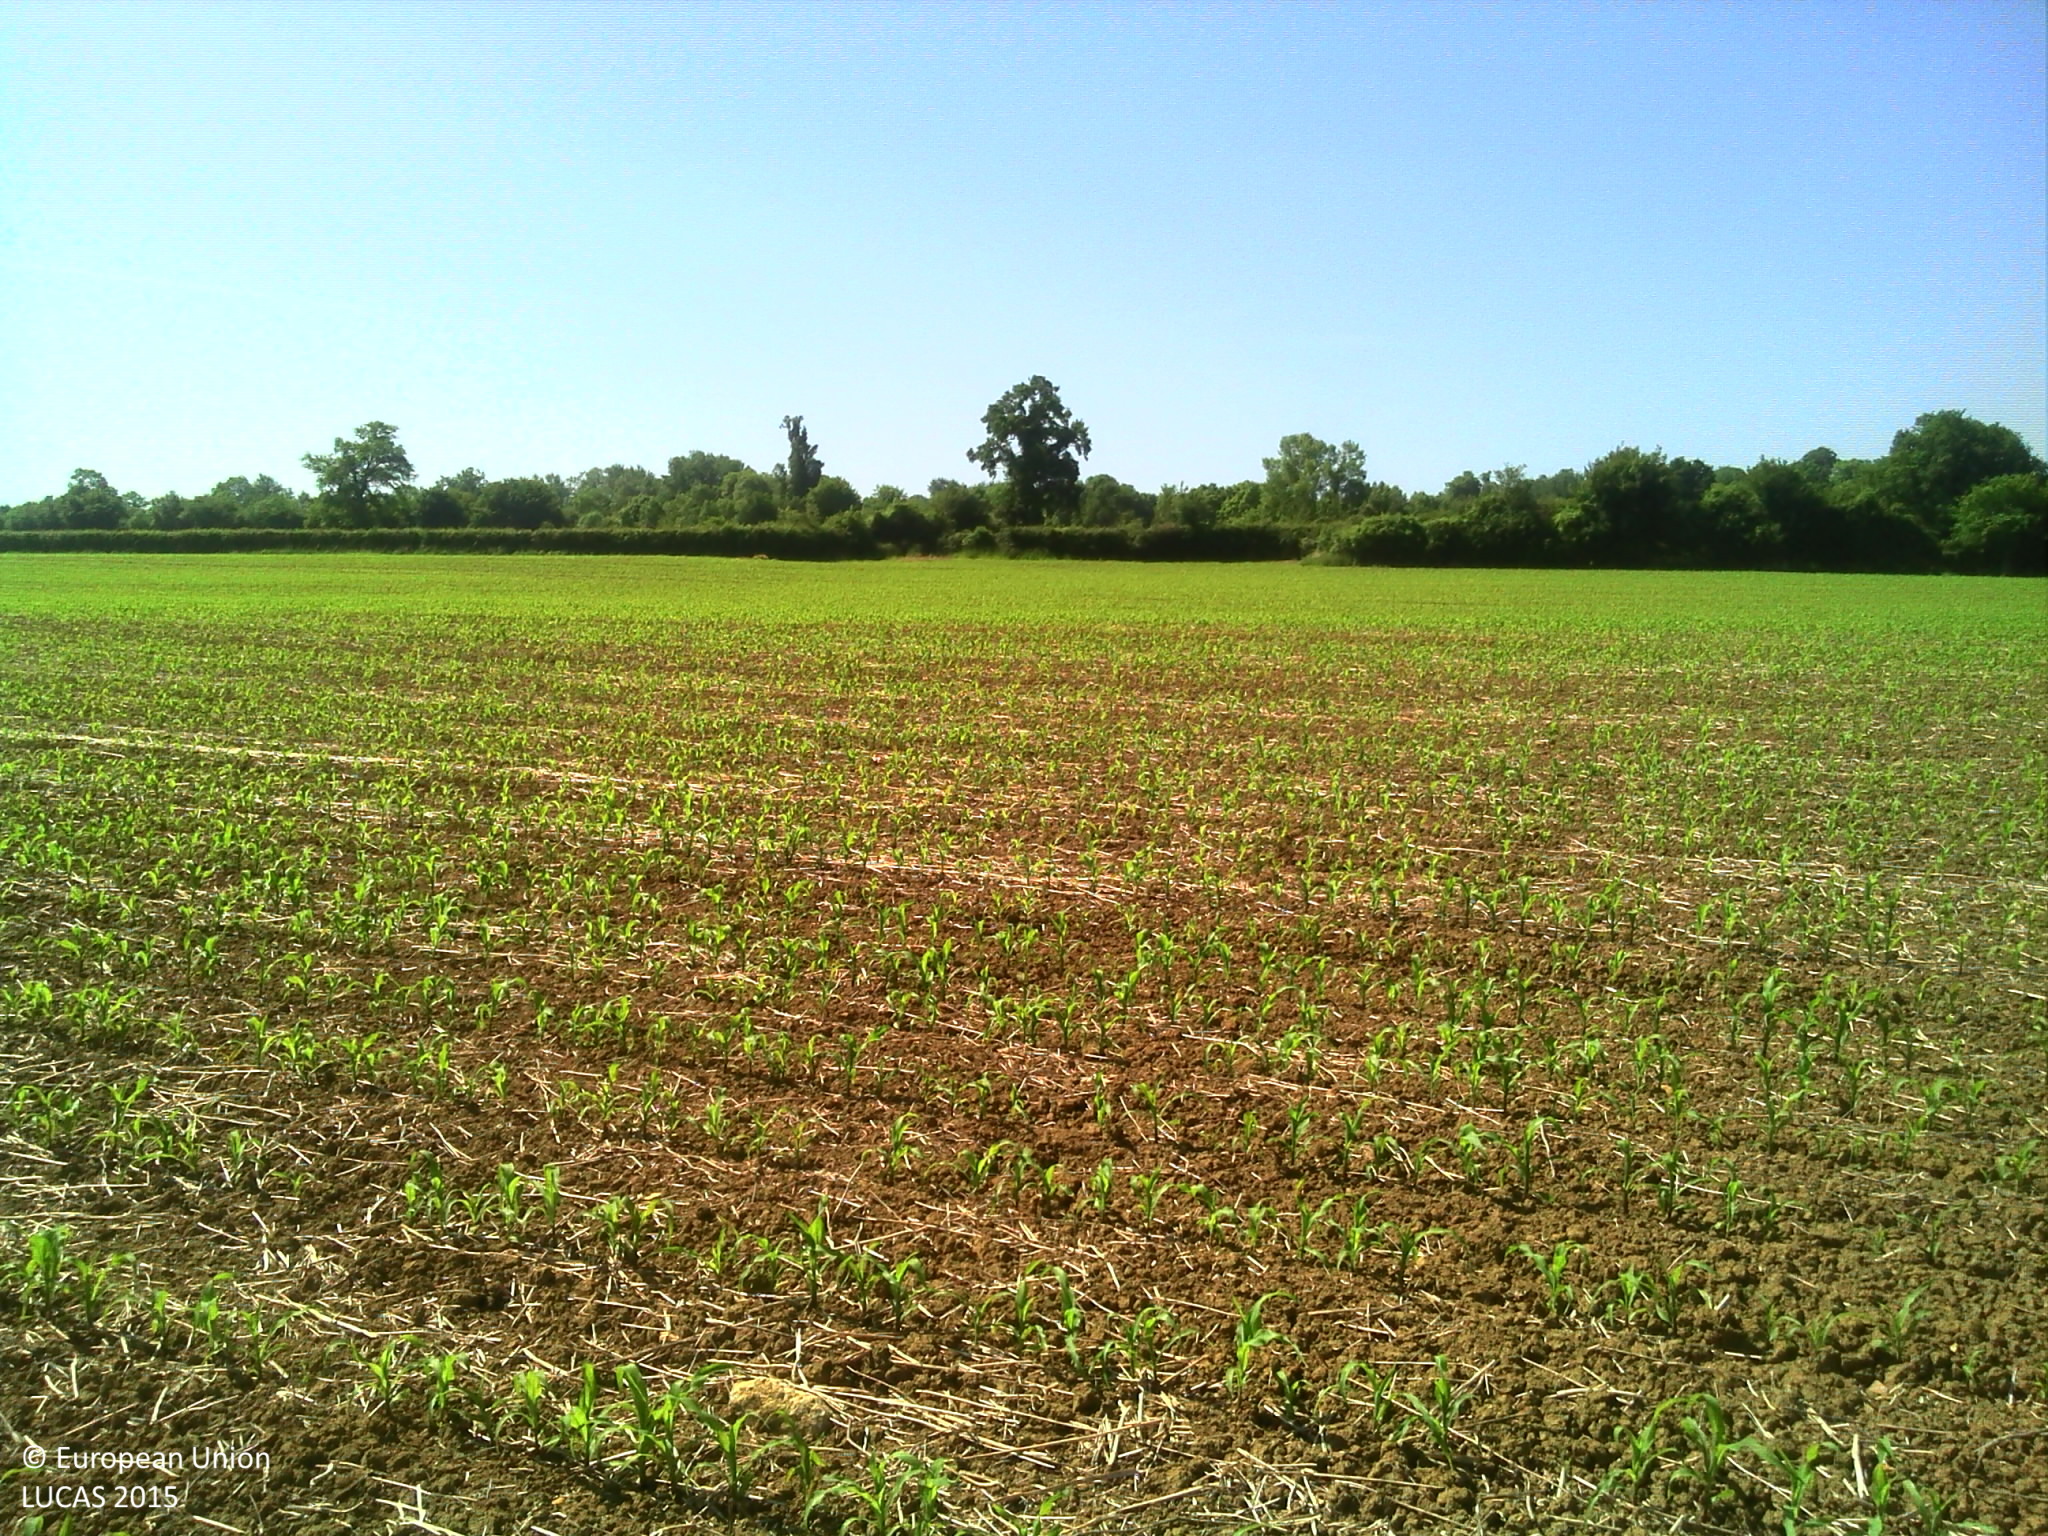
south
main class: Cropland
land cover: Maize
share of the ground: < 10 %
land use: Agriculture (excluding fallow land and kitchen gardens)
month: June
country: FR
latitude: 48.7743
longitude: 0.1055
